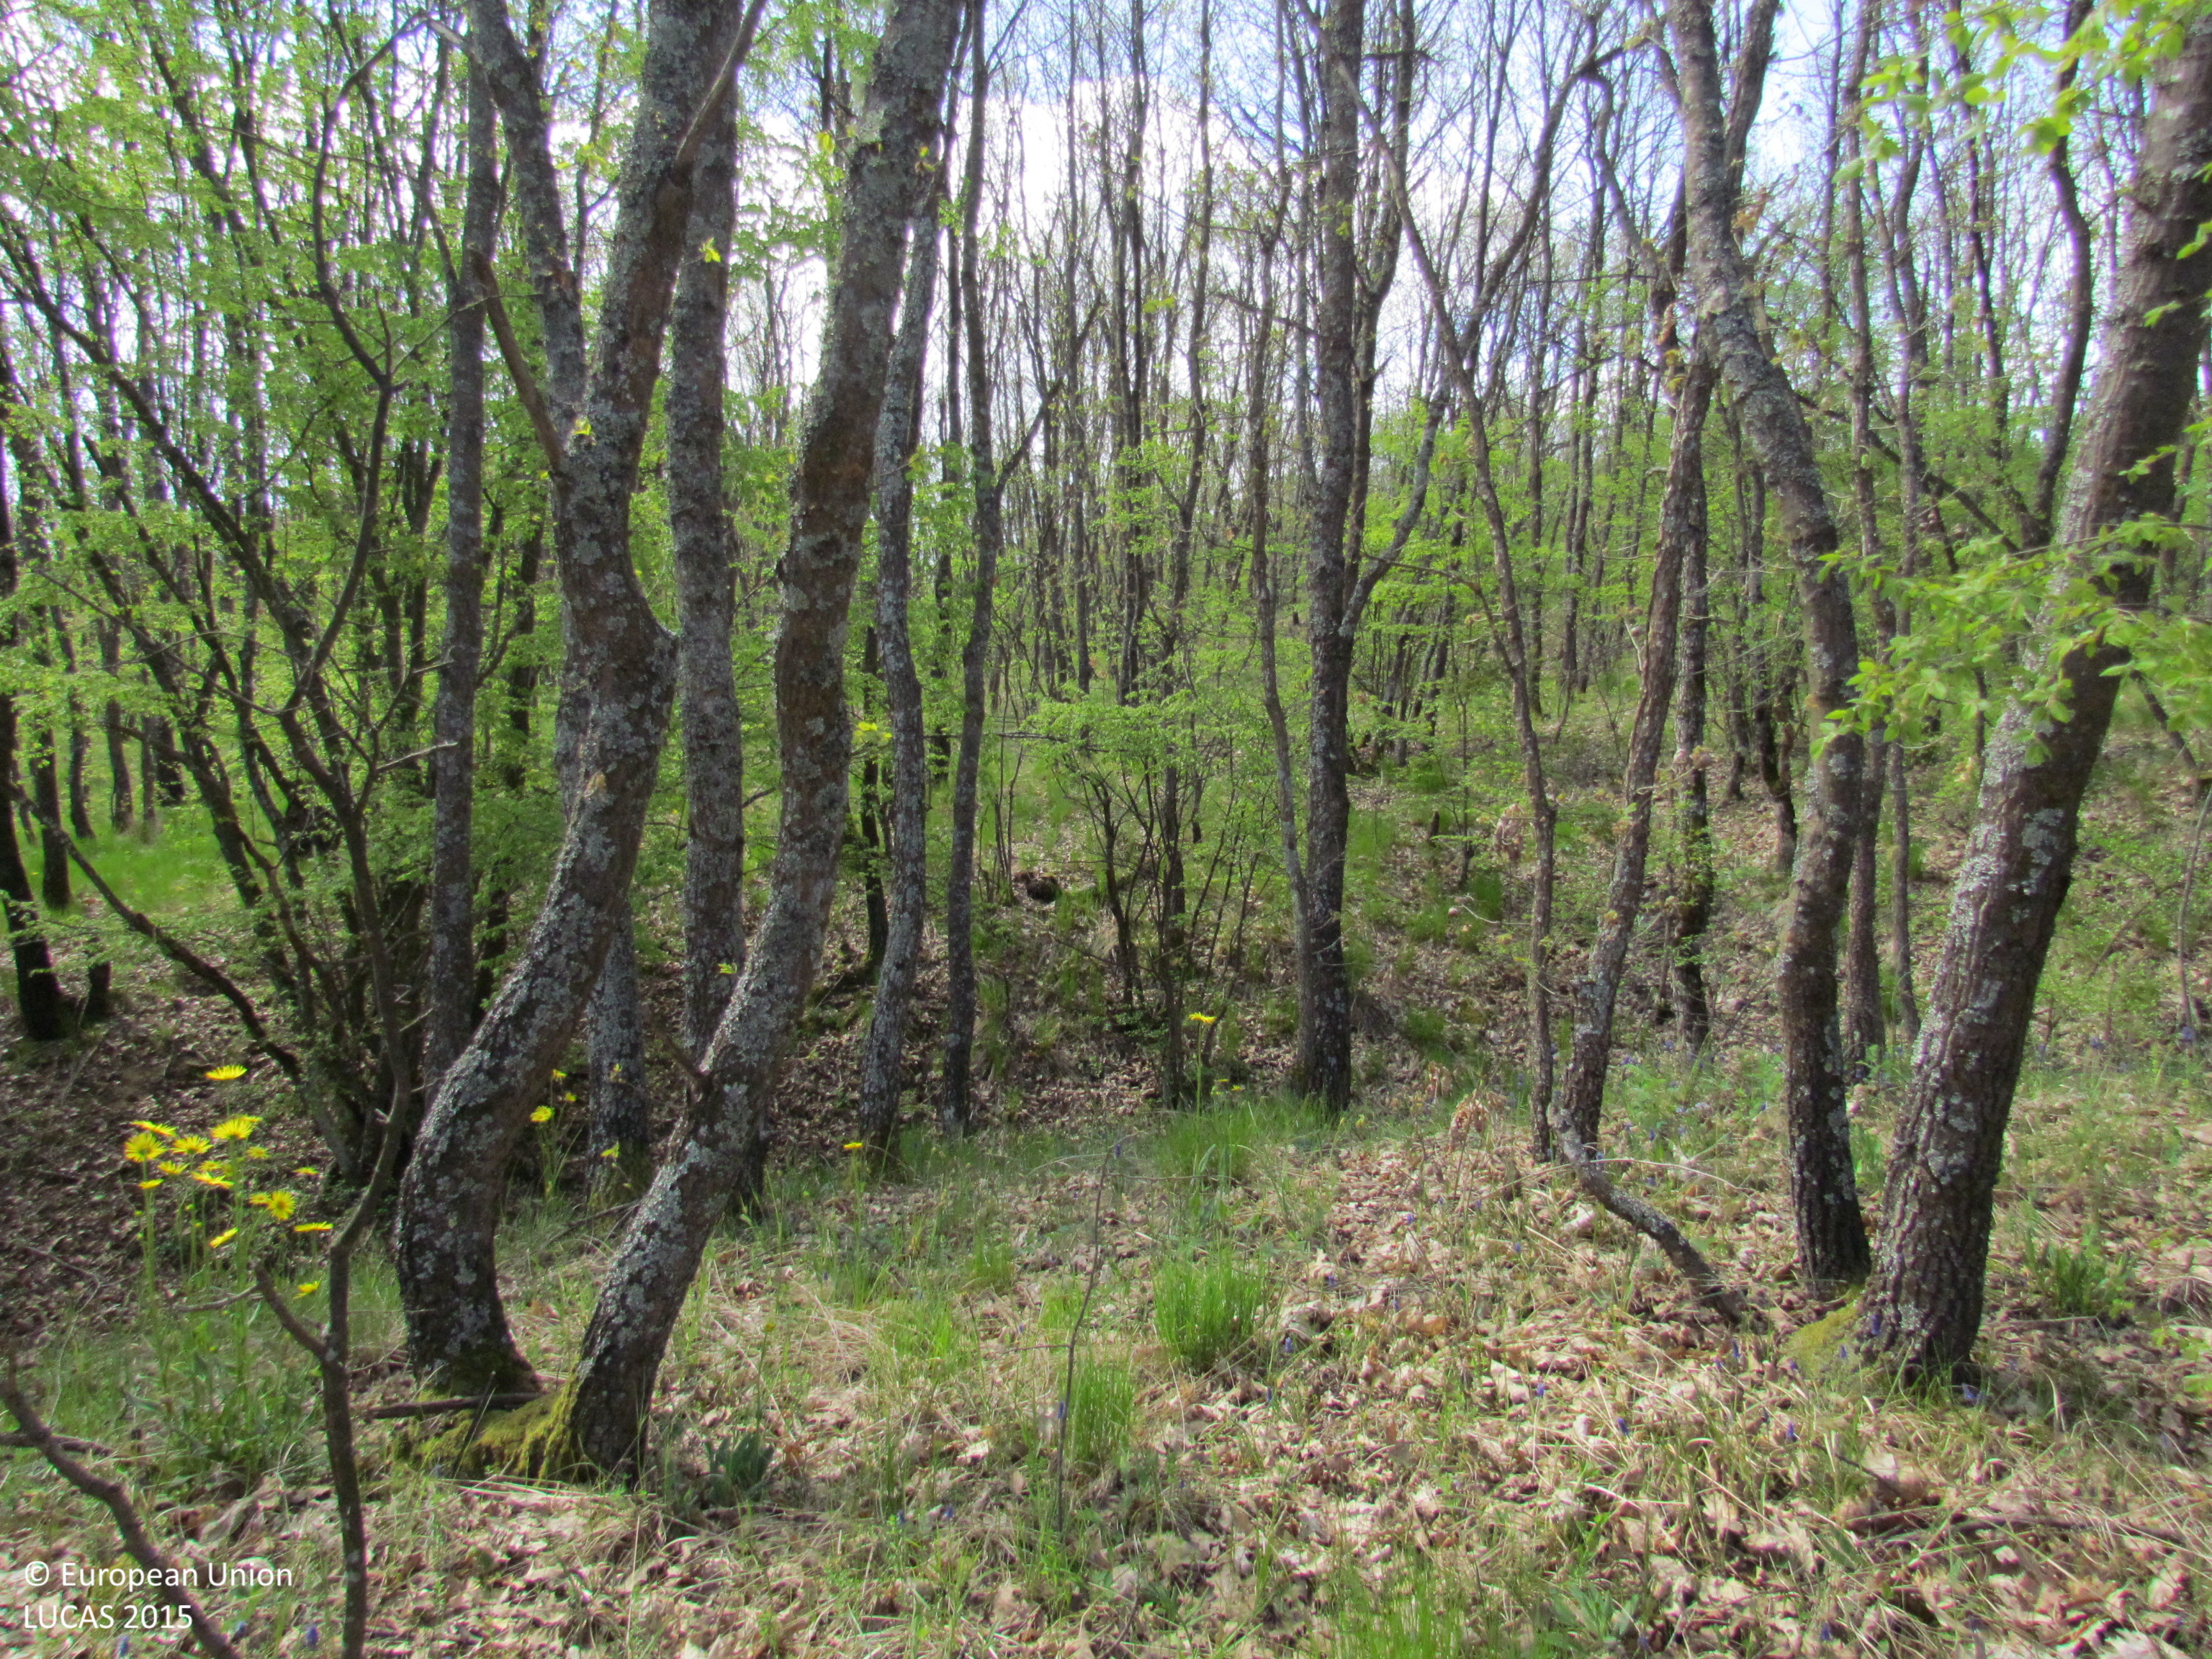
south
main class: Woodland
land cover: Broadleaved woodland
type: mesophytic deciduous forest
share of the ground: 50 - 75 %
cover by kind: broadleaved forest trees 70 %, consolidated bare surface 25 %, herbaceous plants 5 %
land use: Forestry
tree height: > 5 m
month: April
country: BG
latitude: 42.7834
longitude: 26.5881
